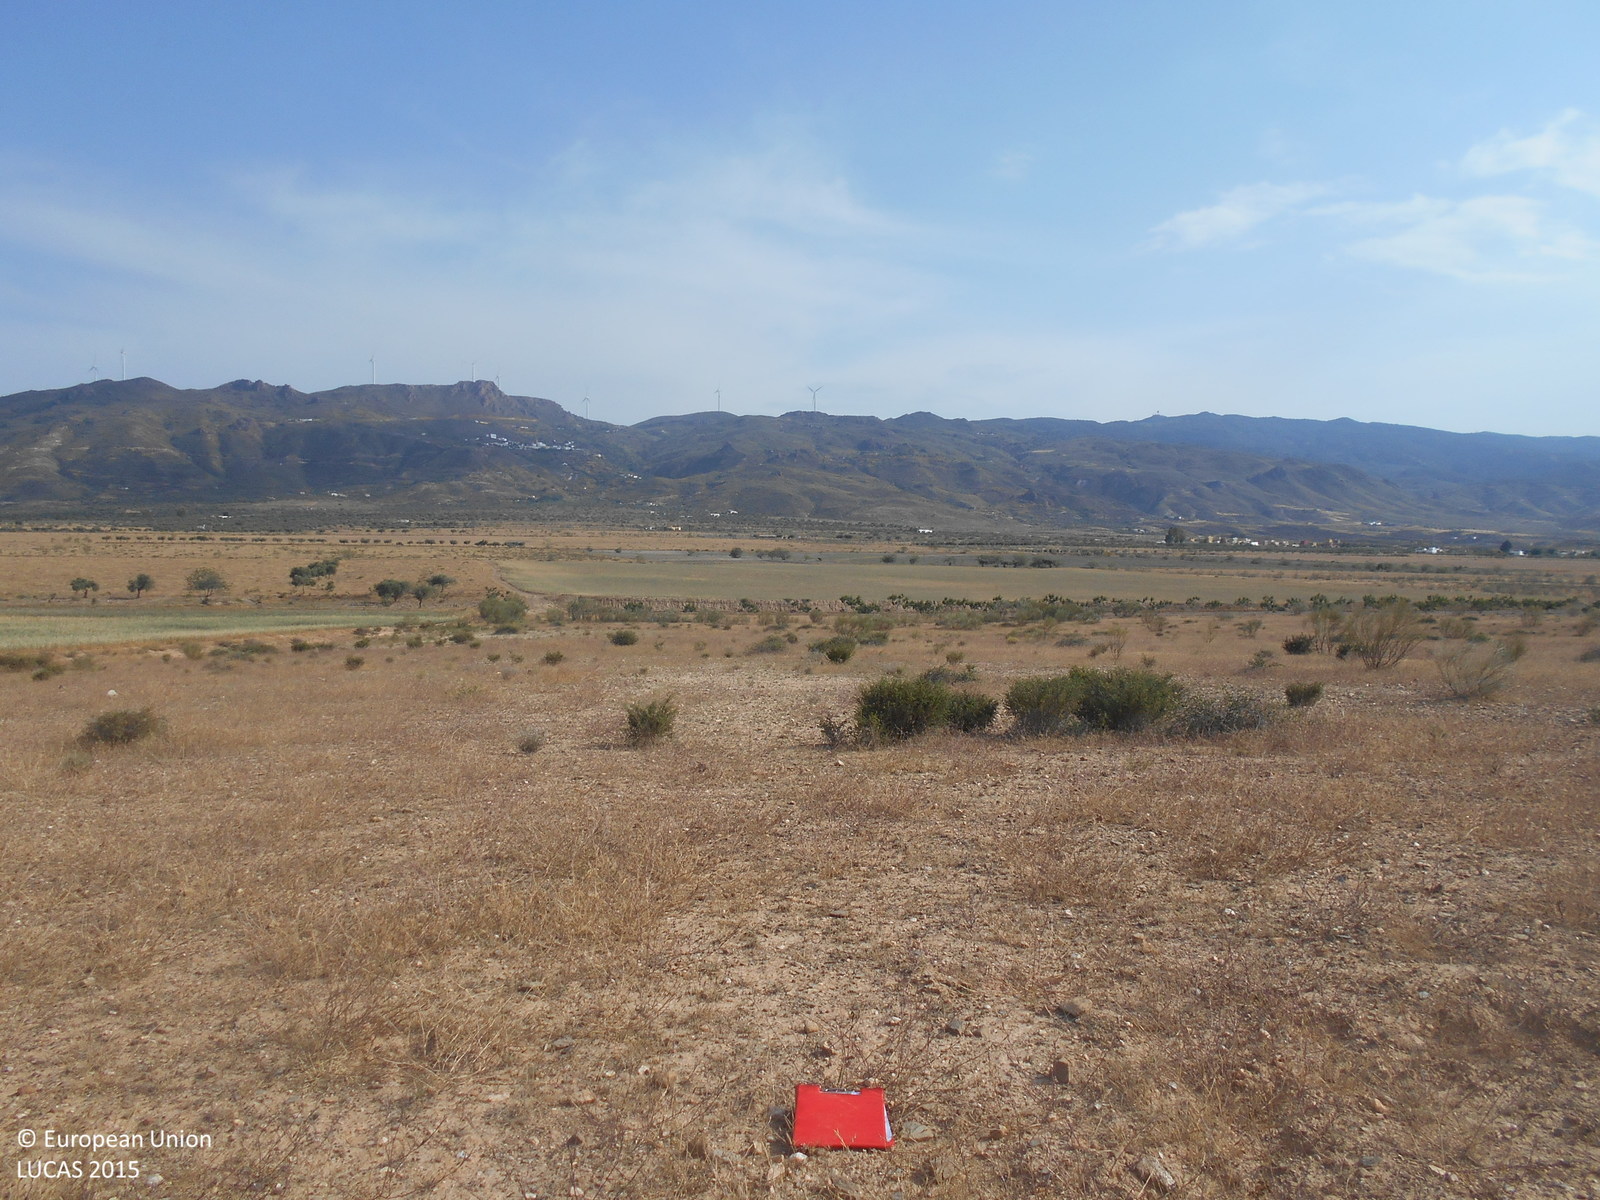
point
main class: Grassland
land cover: Grassland without tree/shrub cover
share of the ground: 25 - 50 %
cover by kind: unconsolidated bare surface 60 %, herbaceous plants 35 %, shrubs 5 %
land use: Abandoned areas
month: May
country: ES
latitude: 37.0598
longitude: -2.2690
